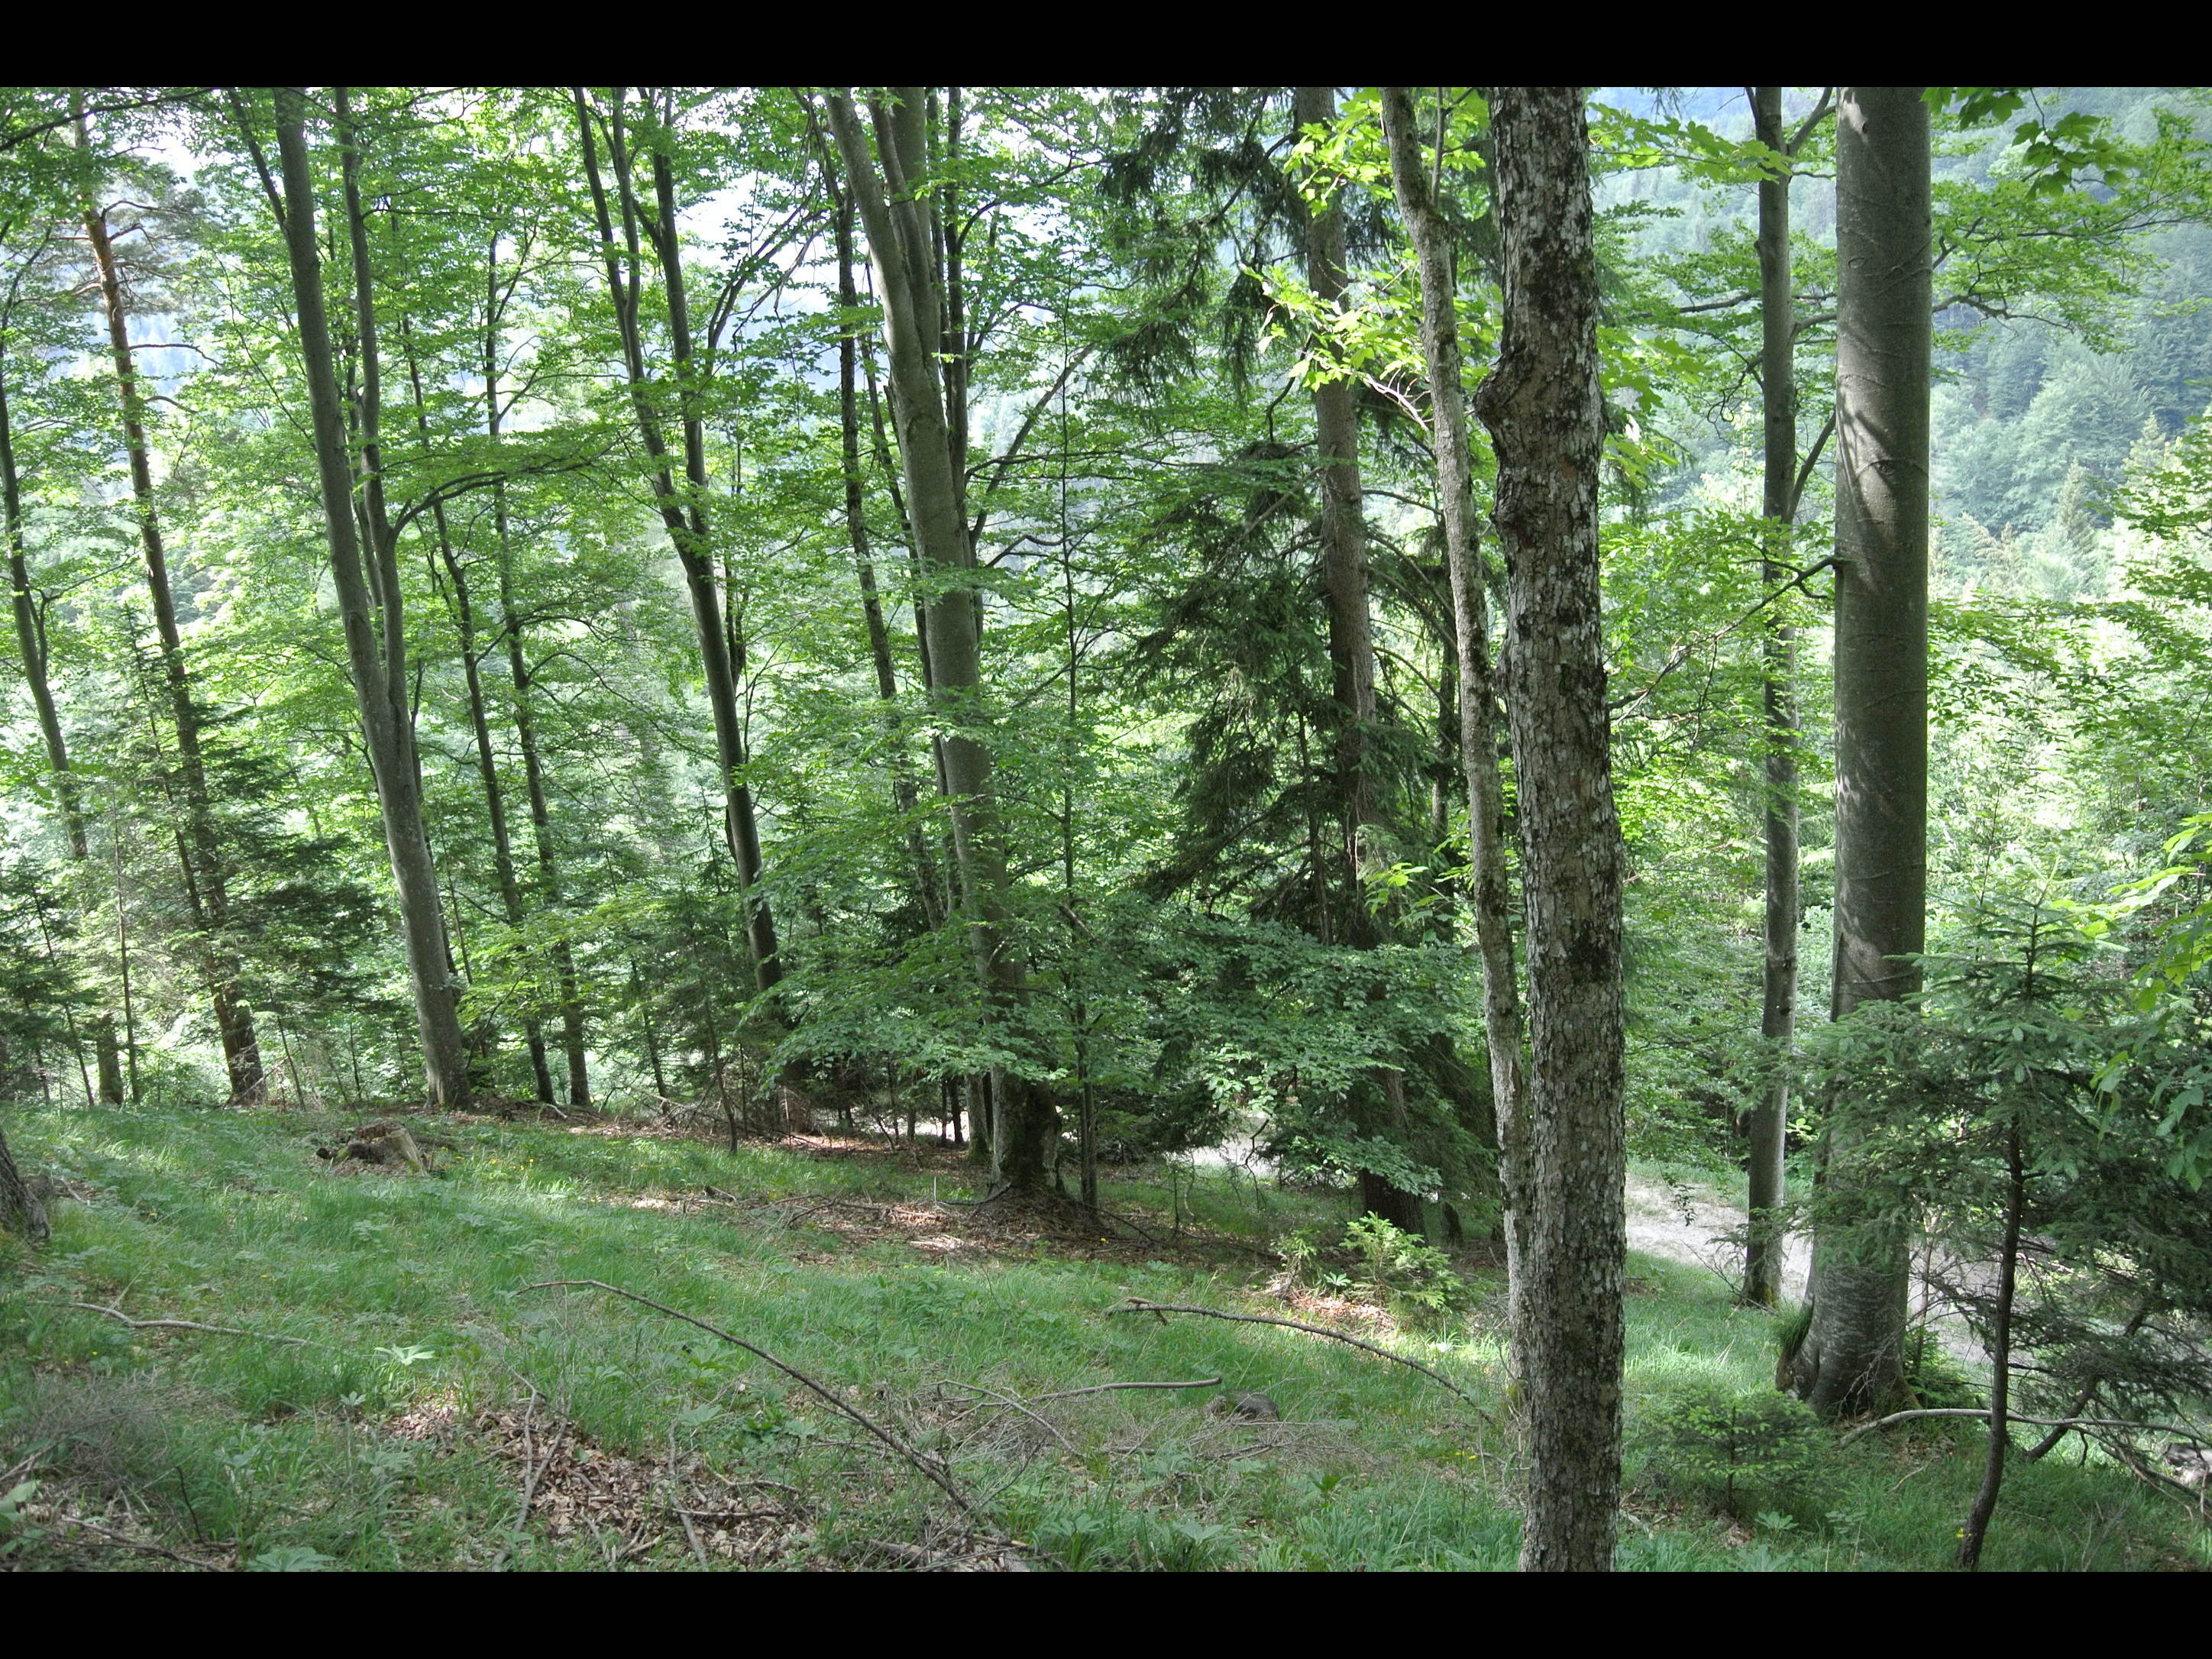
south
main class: Woodland
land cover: Other mixed woodland
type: alpine coniferous forest
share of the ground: > 75 %
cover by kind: broadleaved forest trees 70 %, coniferous forest trees 30 %
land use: Forestry
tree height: > 5 m
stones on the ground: < 10 %
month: June
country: AT
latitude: 47.9115
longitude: 15.7423
